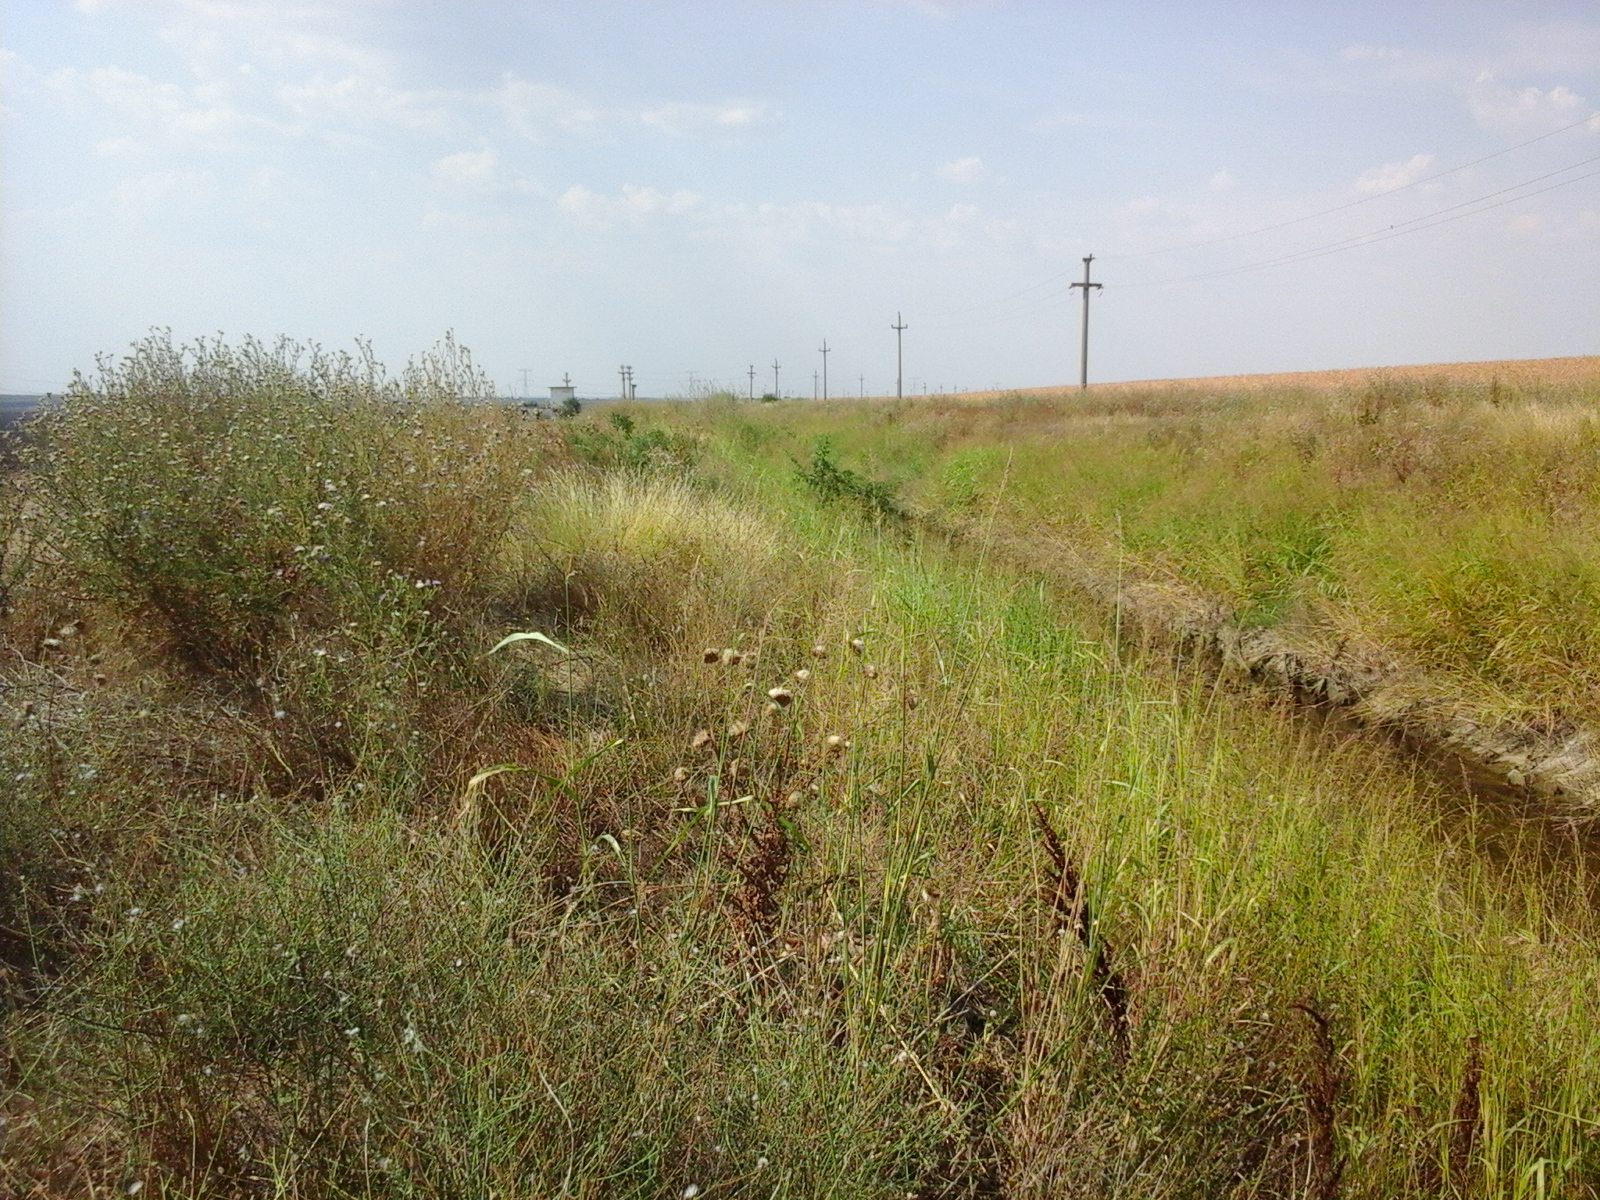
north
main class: Cropland
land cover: Maize
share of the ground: > 75 %
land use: Agriculture (excluding fallow land and kitchen gardens)
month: August
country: RO
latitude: 43.9348
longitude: 23.6670
